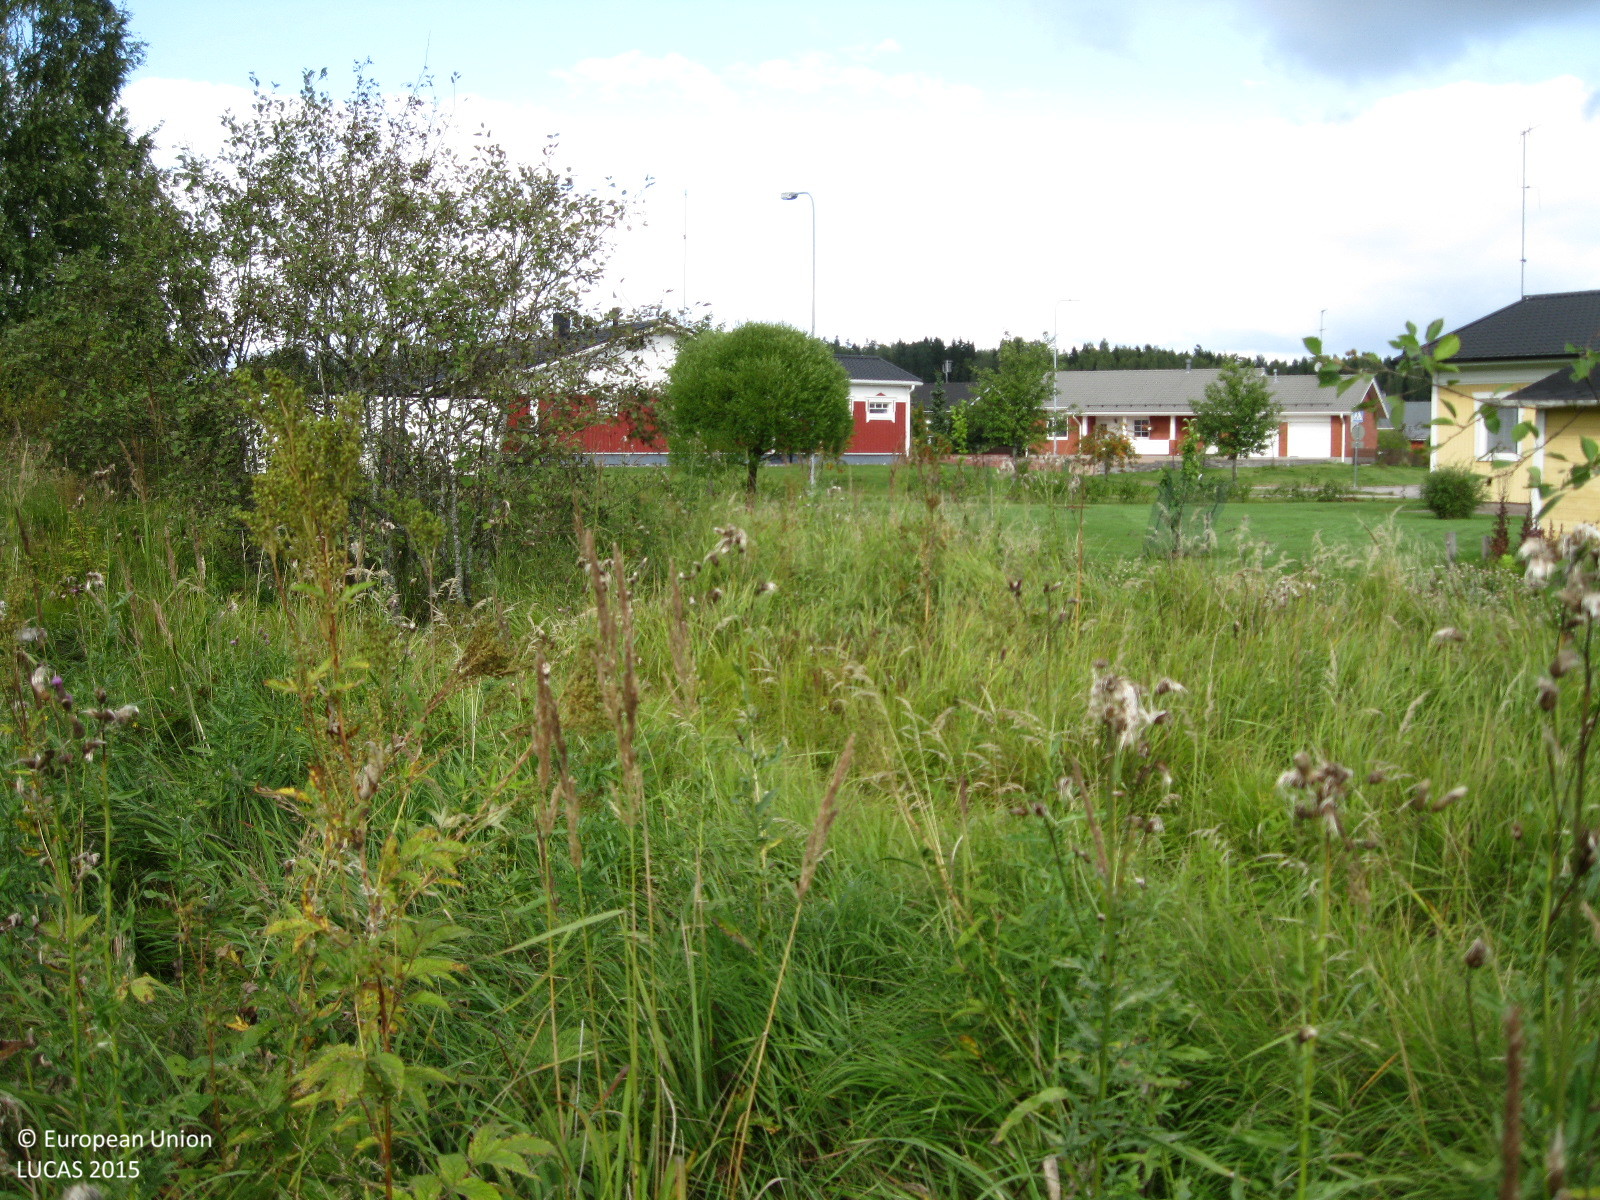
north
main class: Grassland
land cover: Grassland with sparse tree/shrub cover
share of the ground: > 75 %
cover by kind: herbaceous plants 95 %, broadleaved forest trees 5 %
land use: Residential
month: September
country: FI
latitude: 60.4741
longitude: 24.8303
